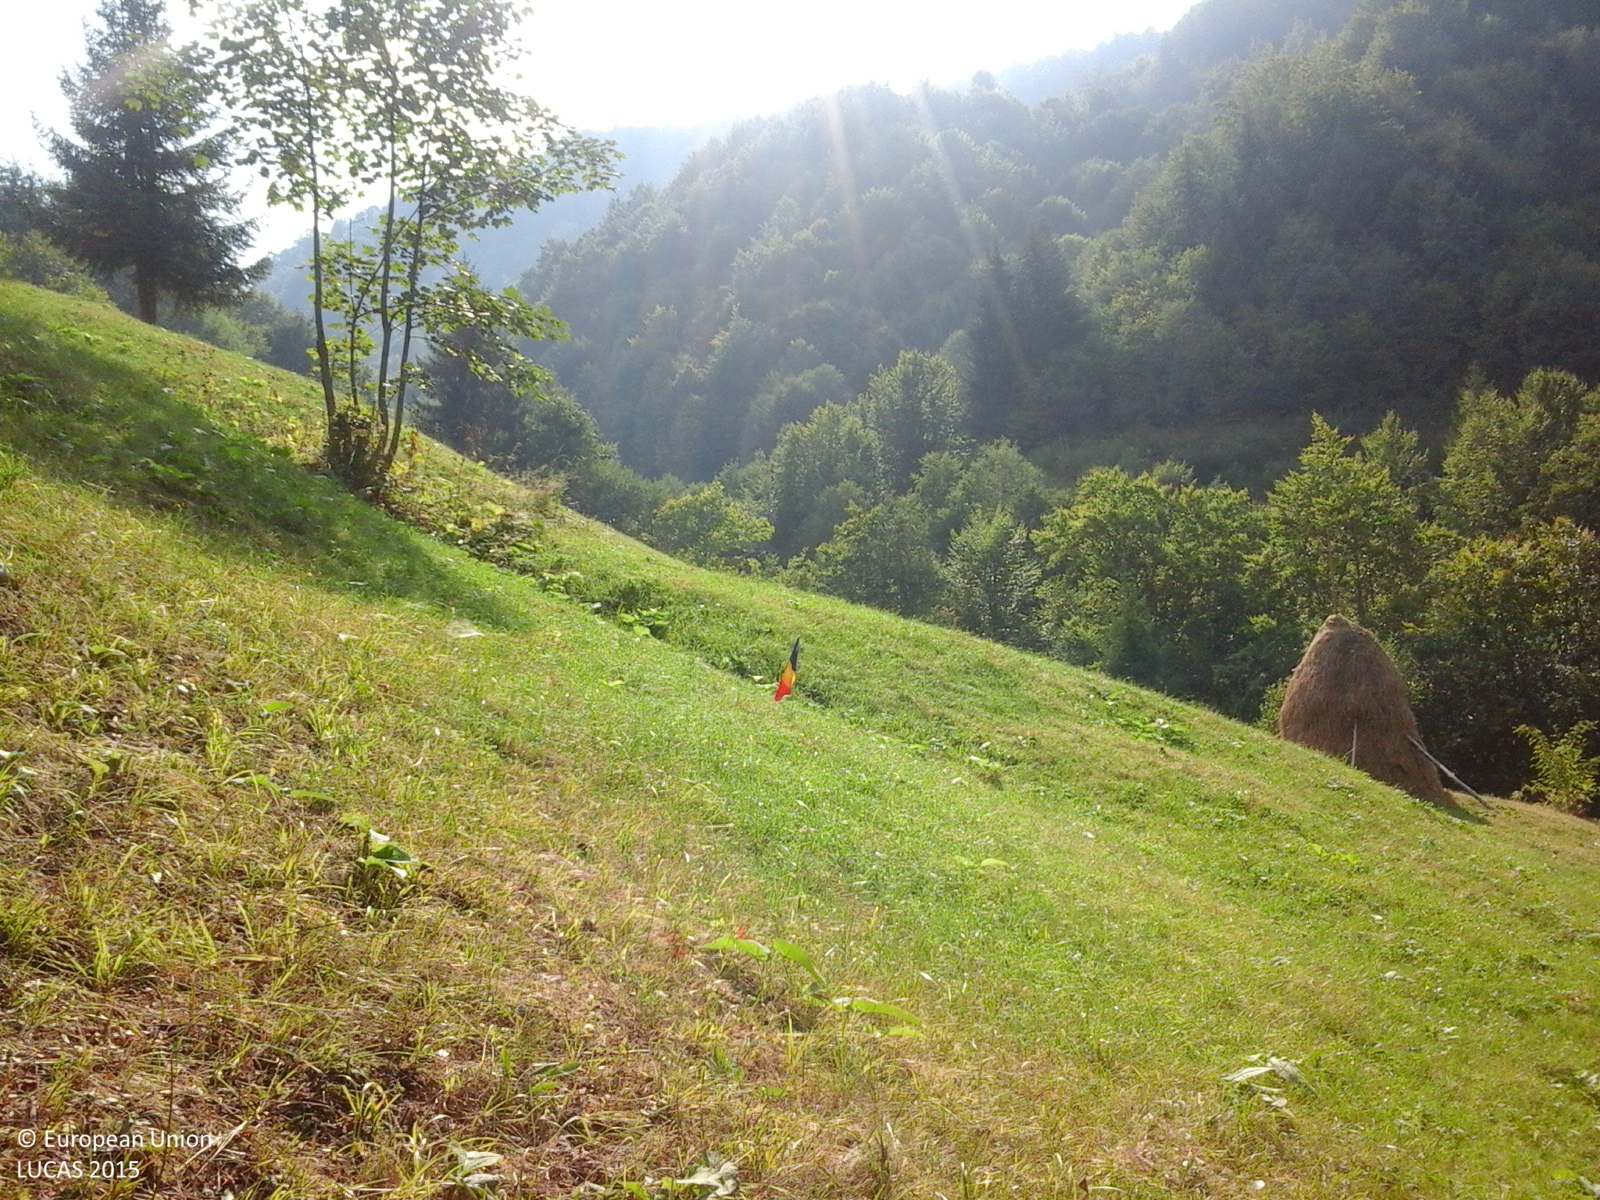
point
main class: Grassland
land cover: Grassland without tree/shrub cover
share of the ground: > 75 %
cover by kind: herbaceous plants 100 %
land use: Agriculture (excluding fallow land and kitchen gardens)
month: September
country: RO
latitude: 47.7993
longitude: 24.4193
